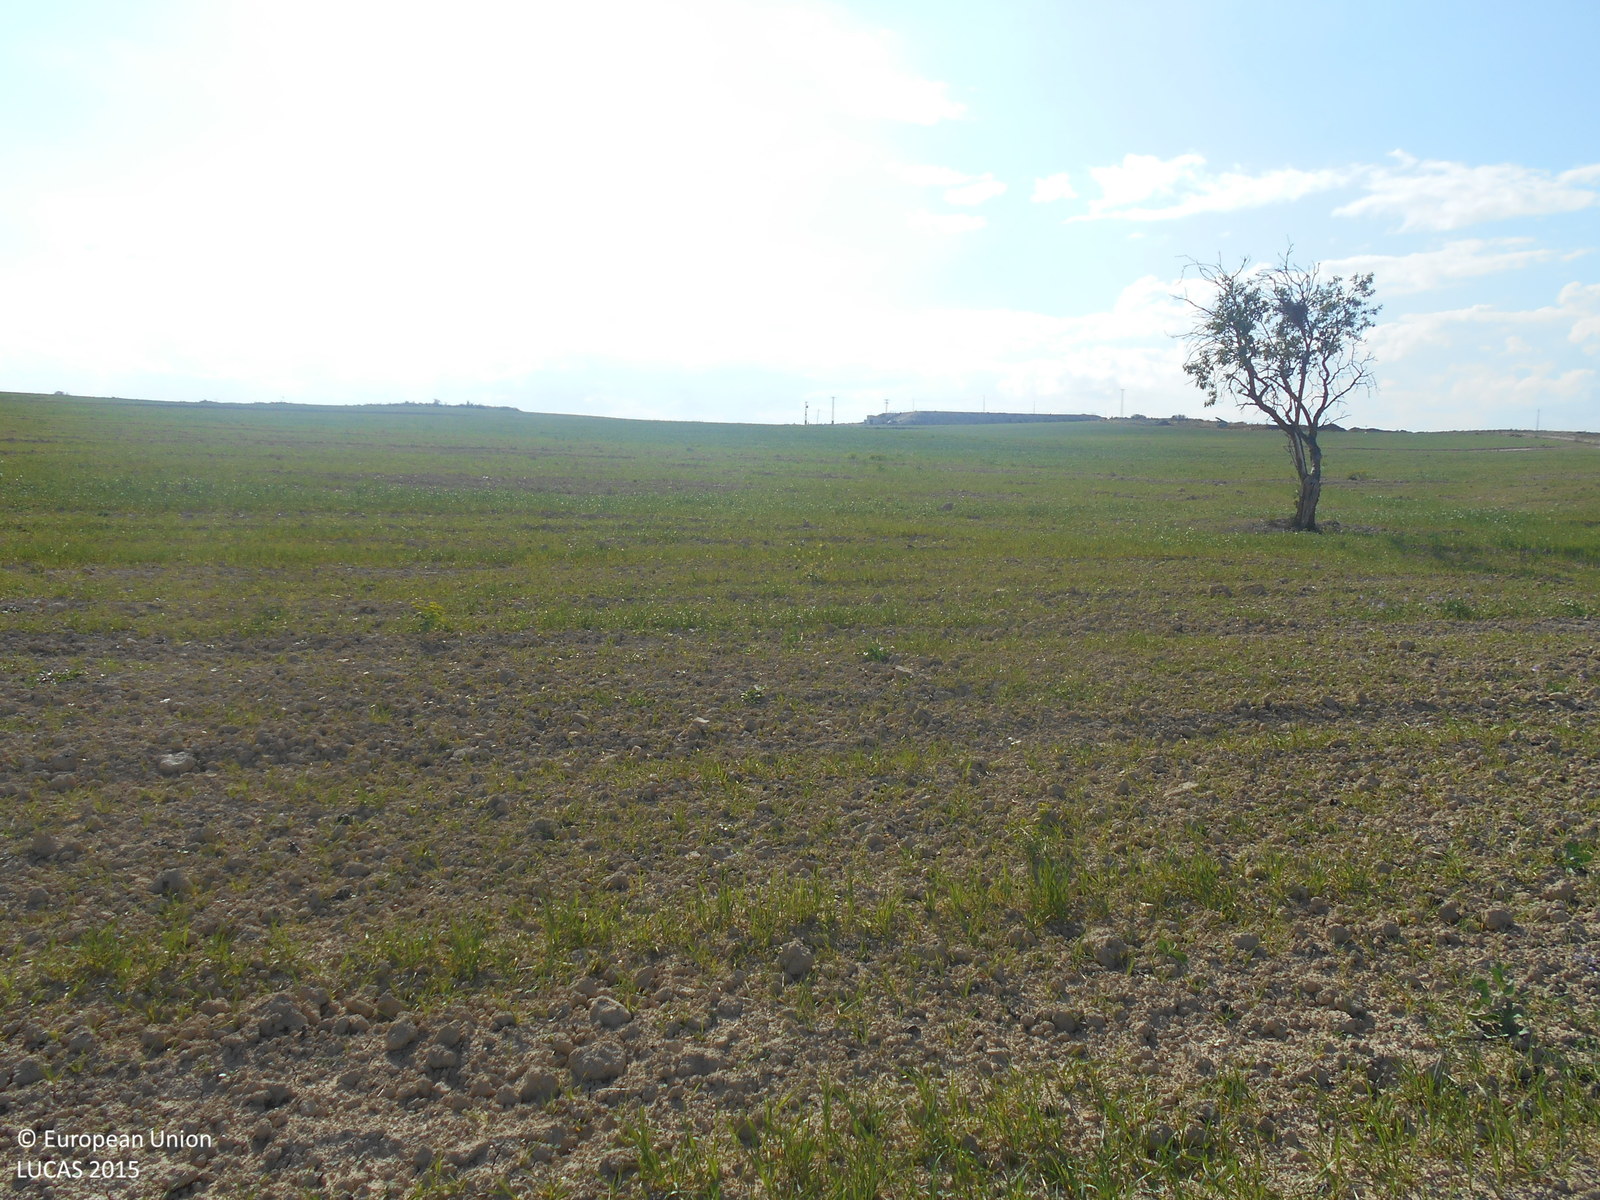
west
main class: Cropland
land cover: Barley
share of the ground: 50 - 75 %
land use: Agriculture (excluding fallow land and kitchen gardens)
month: April
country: ES
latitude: 37.7024
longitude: -1.3803
